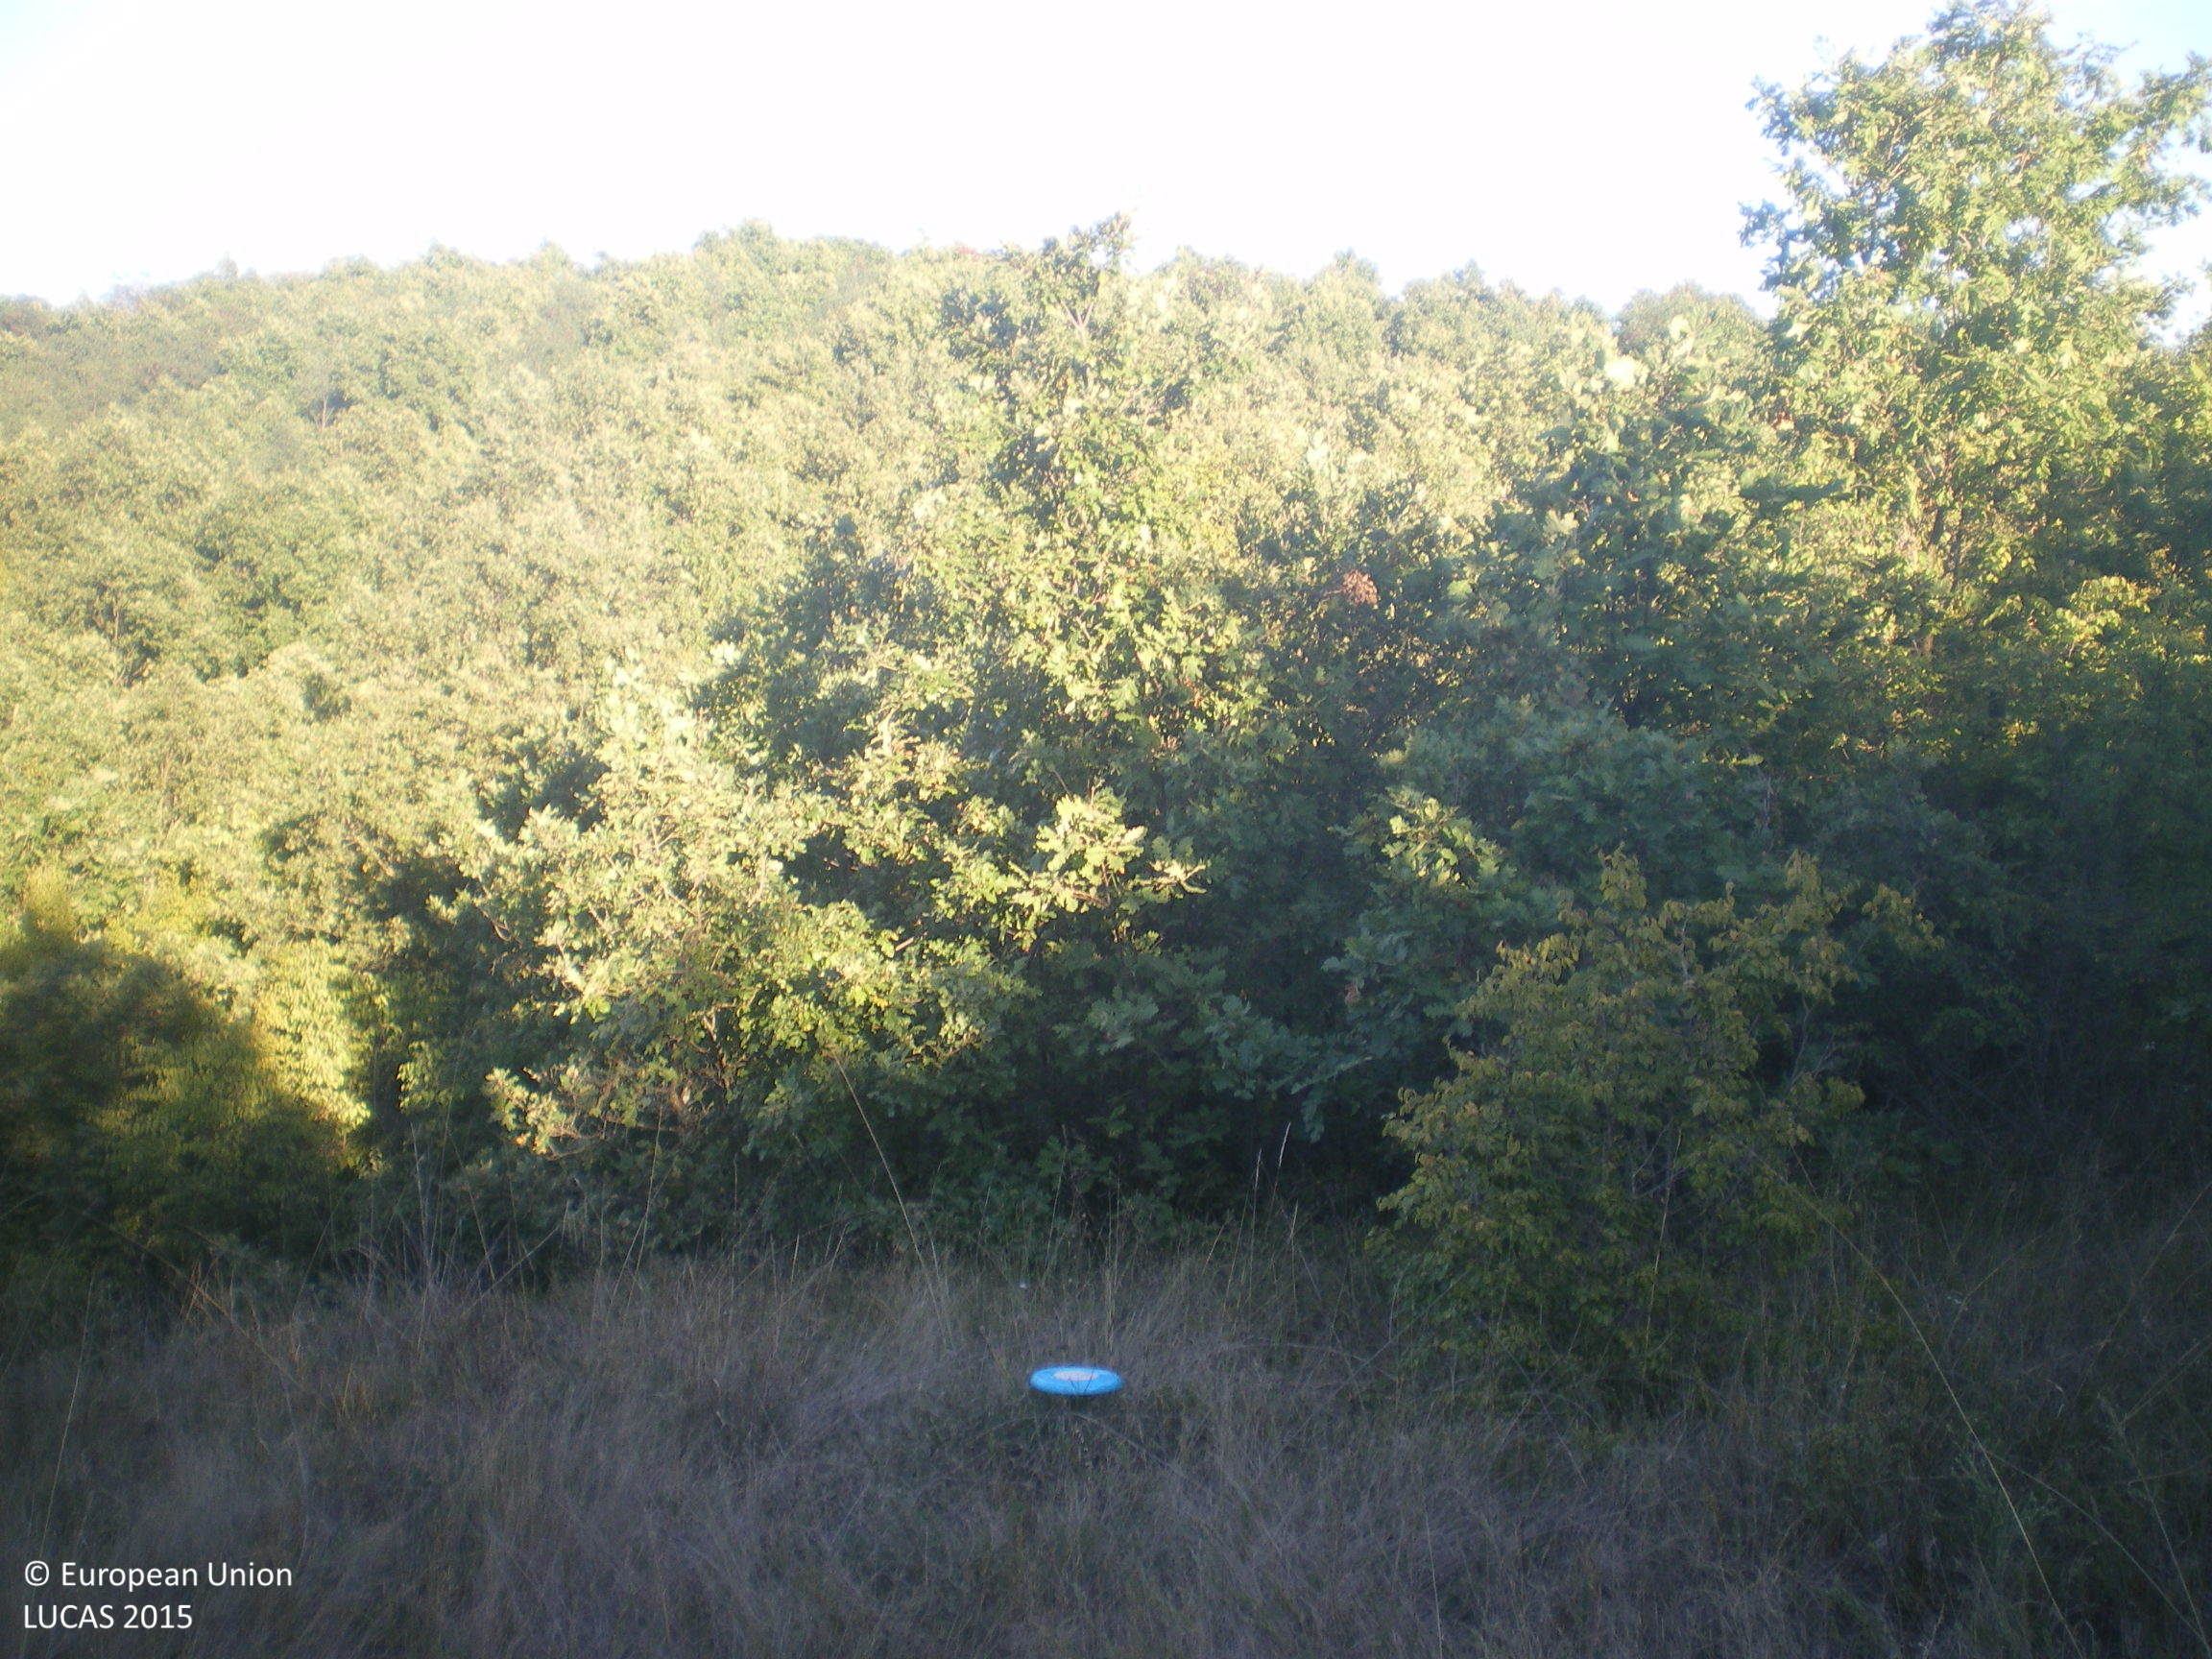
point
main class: Woodland
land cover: Broadleaved woodland
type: mesophytic deciduous forest
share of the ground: 50 - 75 %
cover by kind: broadleaved forest trees 75 %, herbaceous plants 20 %, shrubs 5 %
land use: Forestry
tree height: > 5 m
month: September
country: BG
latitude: 41.8529
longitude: 25.9837
